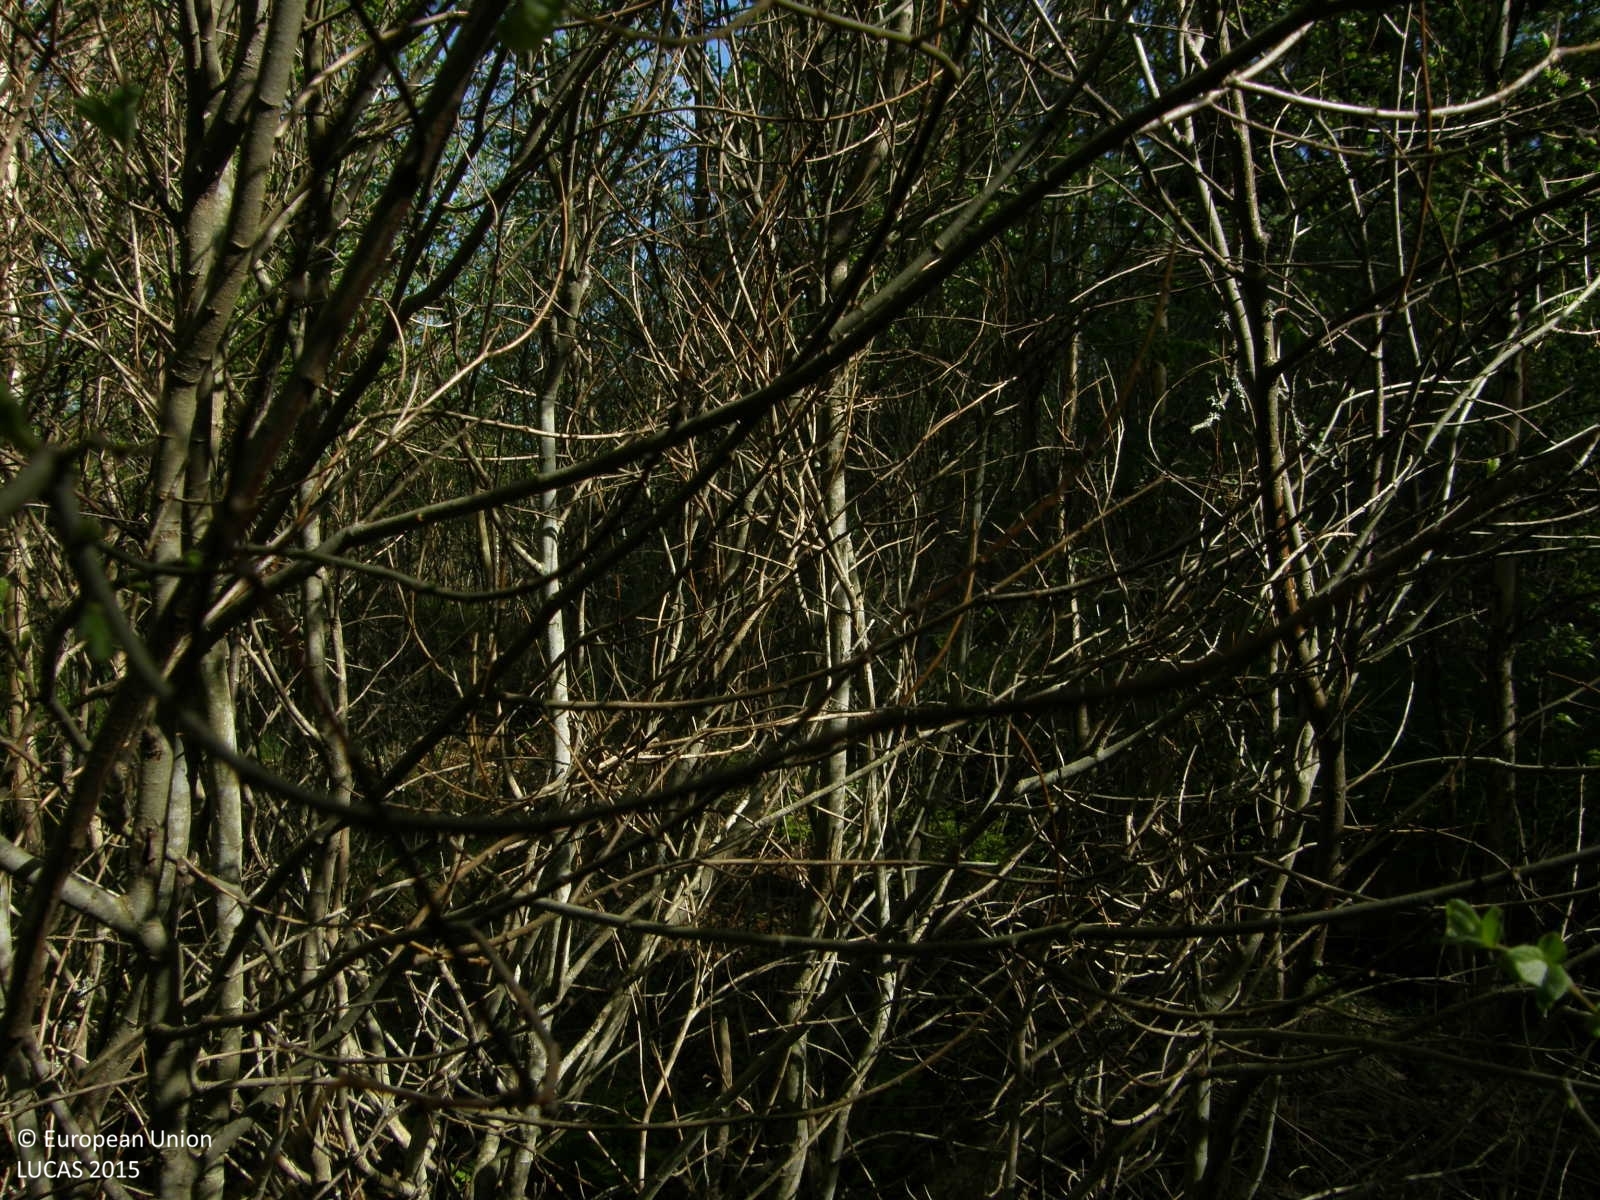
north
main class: Woodland
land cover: Pine dominated mixed woodland
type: boreal forest
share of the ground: > 75 %
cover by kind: coniferous forest trees 50 %, broadleaved forest trees 40 %, shrubs 10 %
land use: Forestry
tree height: > 5 m
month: June
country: FI
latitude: 62.1076
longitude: 21.6017
